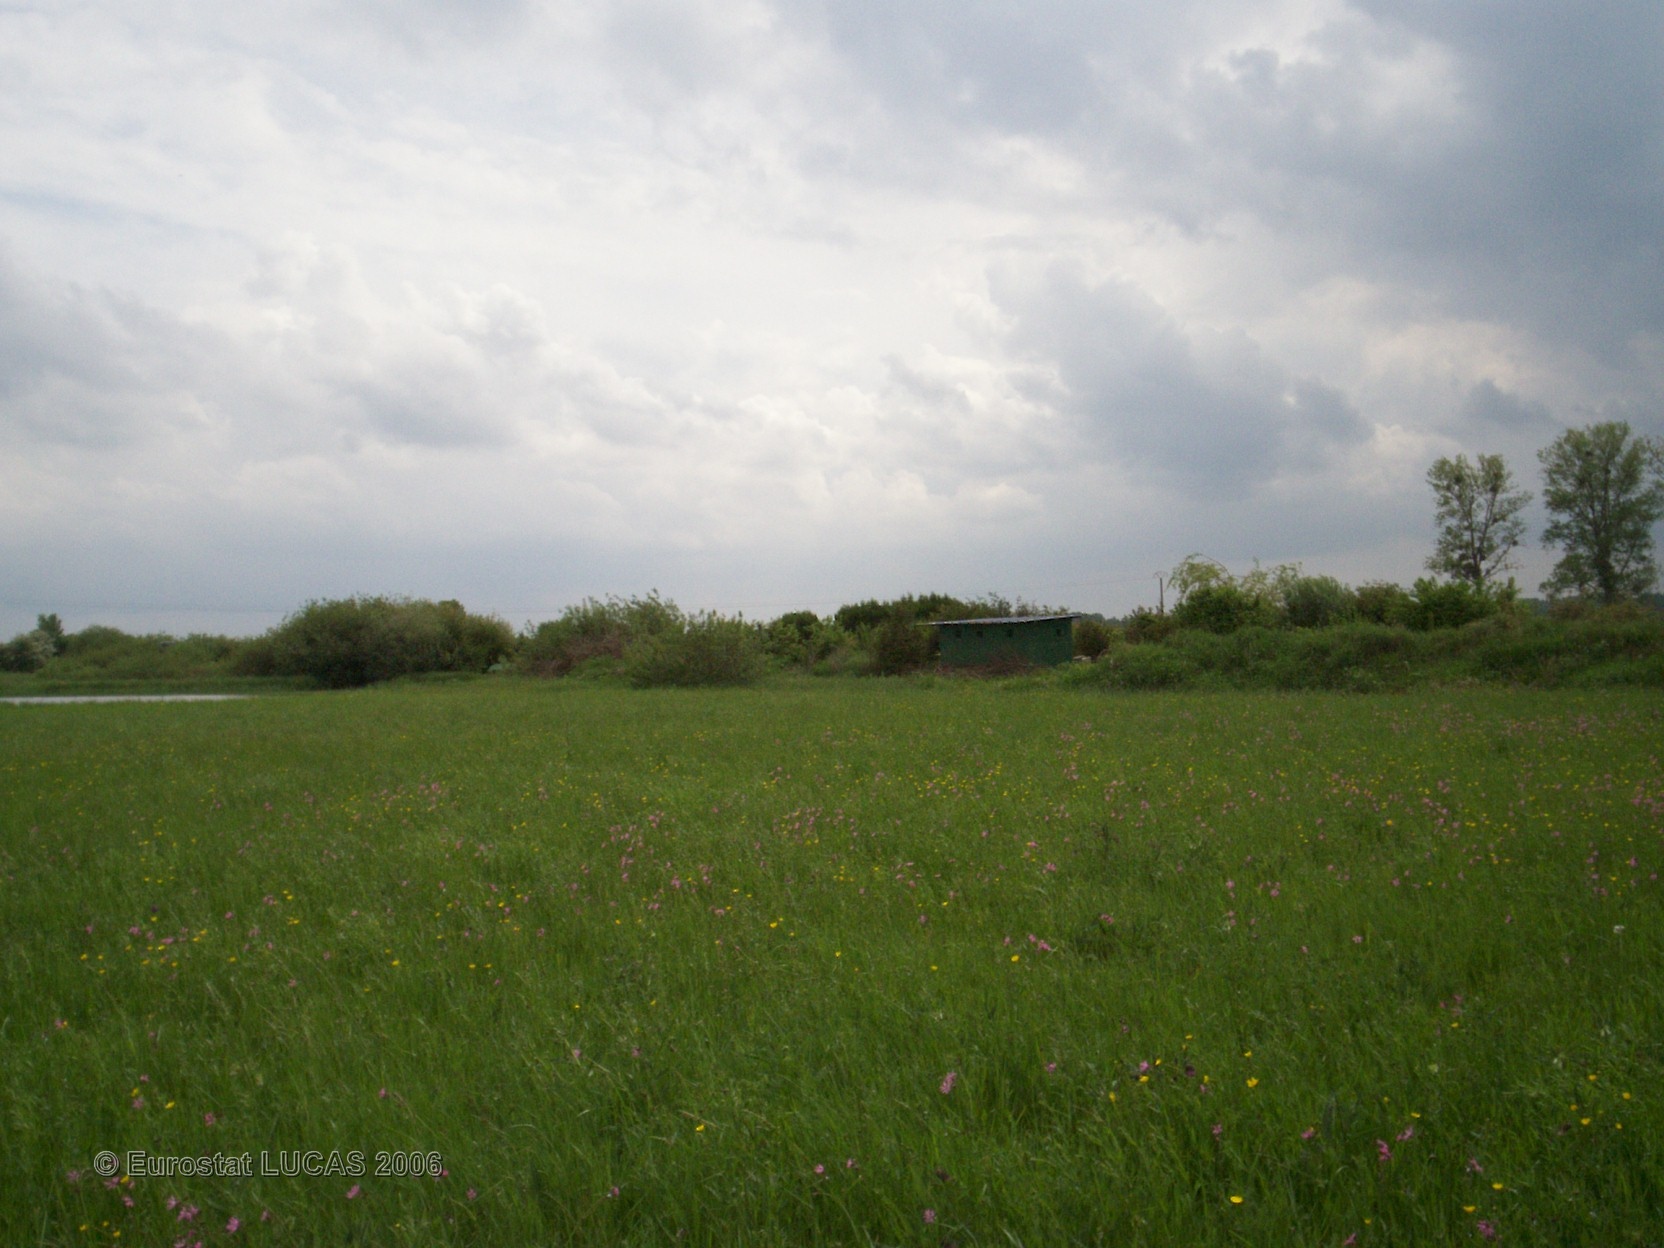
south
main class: Grassland
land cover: Grassland without tree/shrub cover
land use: Agriculture (excluding fallow land and kitchen gardens)
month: May
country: FR
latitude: 49.5791
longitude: 4.4224
